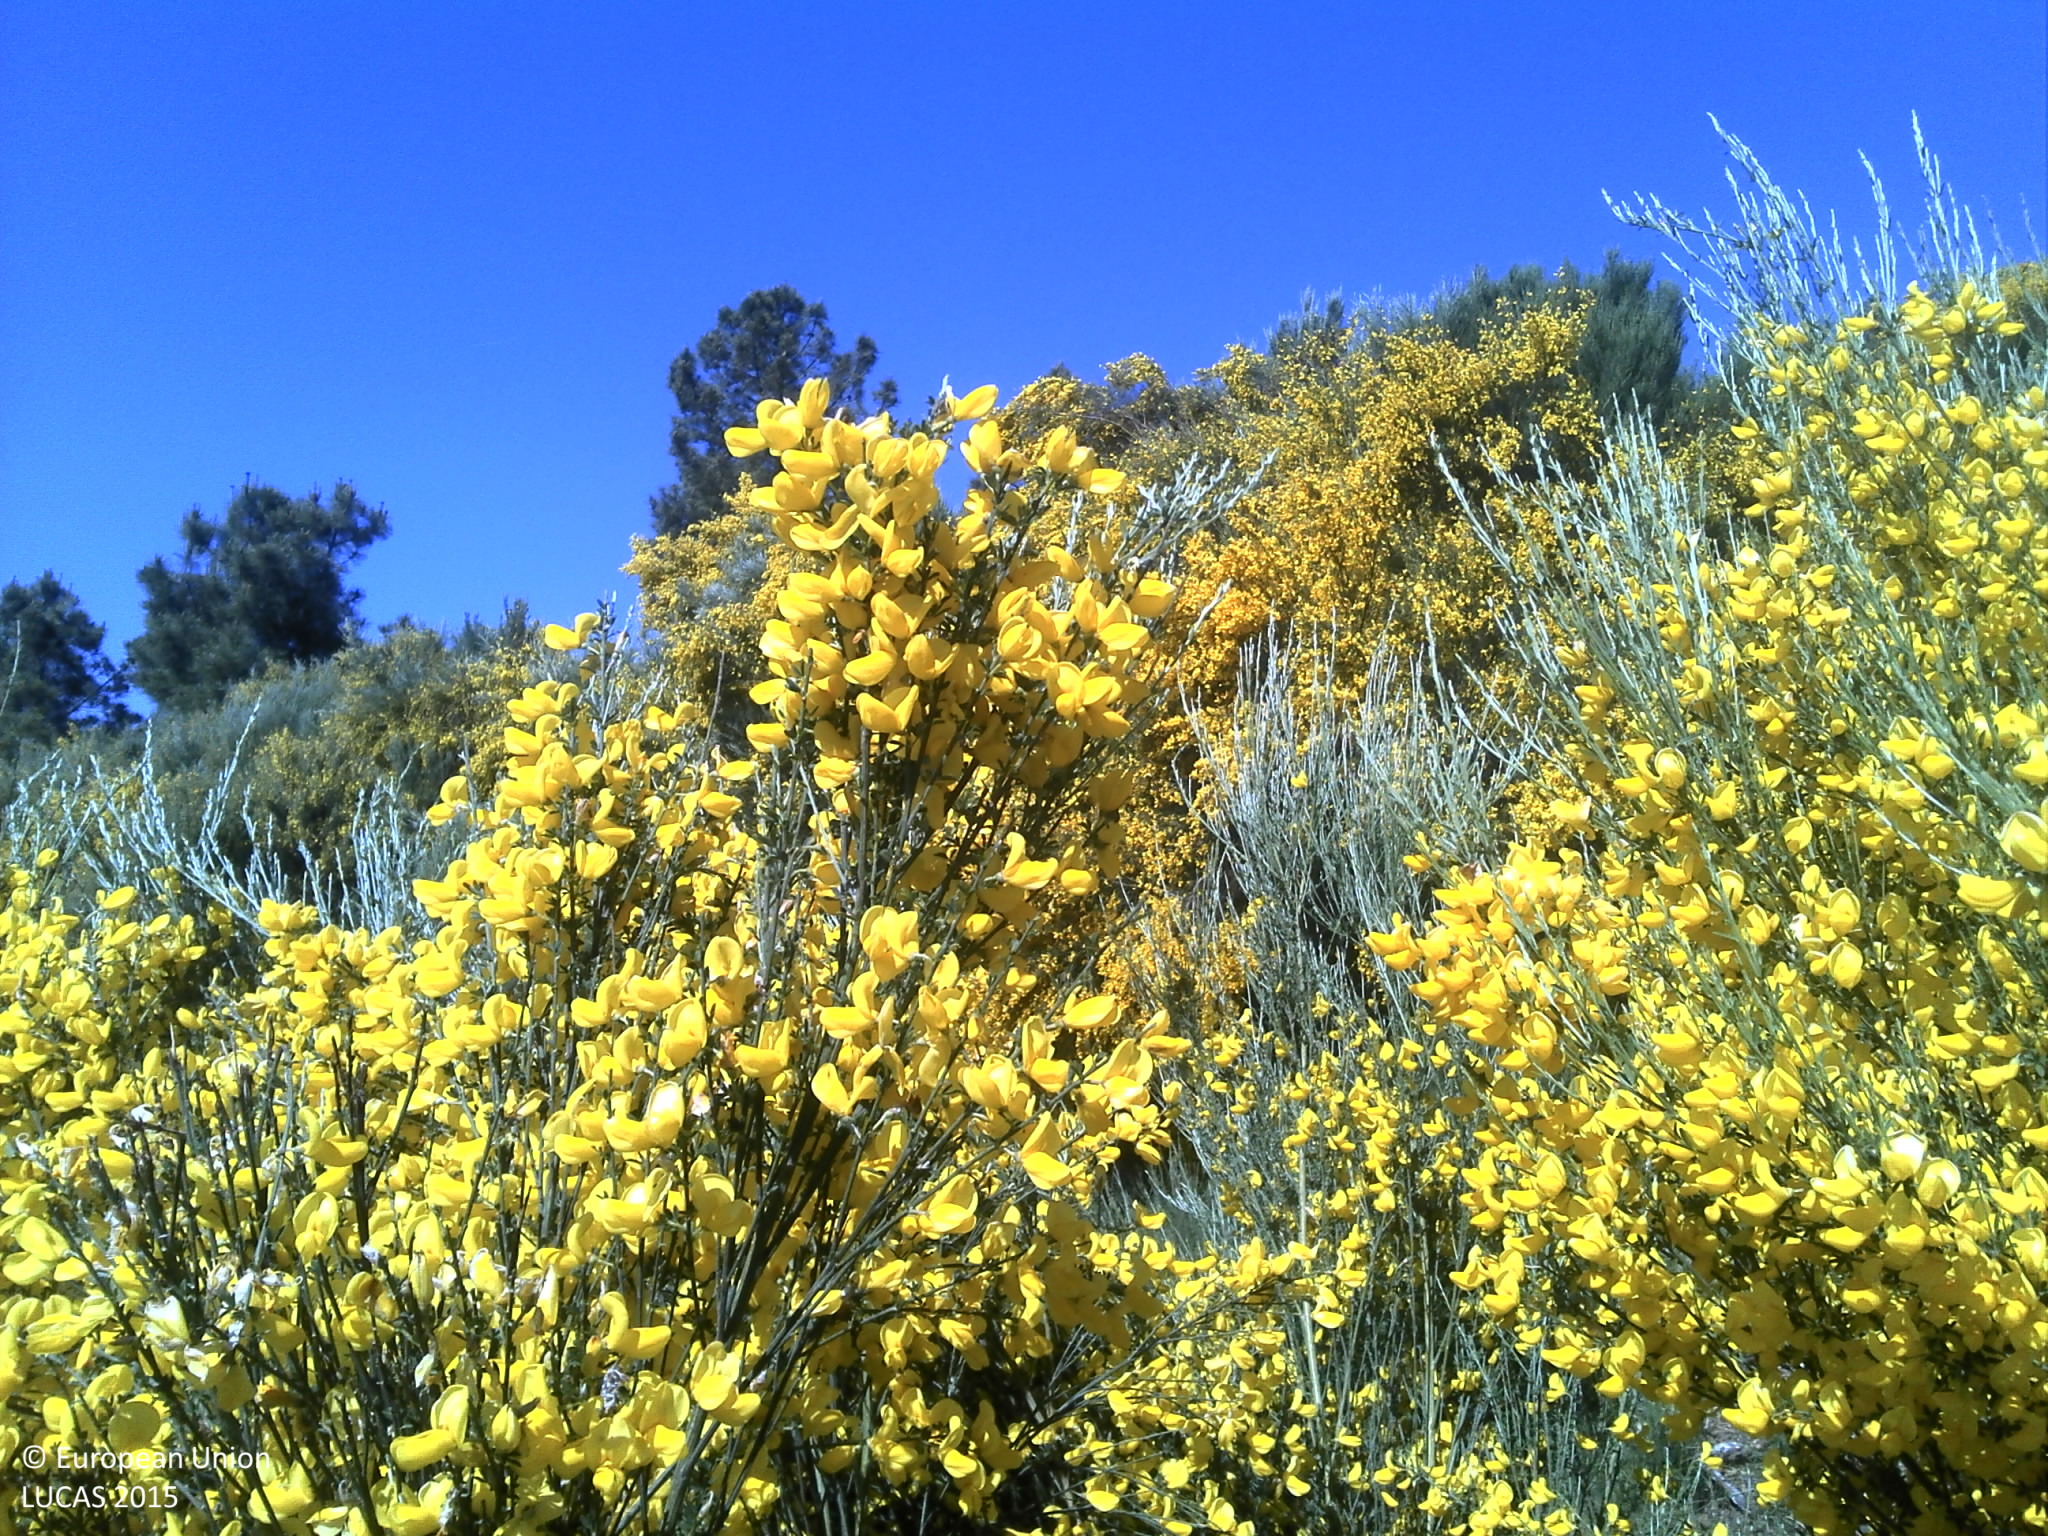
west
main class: Shrubland
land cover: Shrubland without tree cover
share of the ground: 25 - 50 %
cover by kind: shrubs 75 %, unconsolidated bare surface 20 %, herbaceous plants 5 %
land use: Agriculture (excluding fallow land and kitchen gardens)
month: May
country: PT
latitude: 40.5067
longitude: -7.3001
